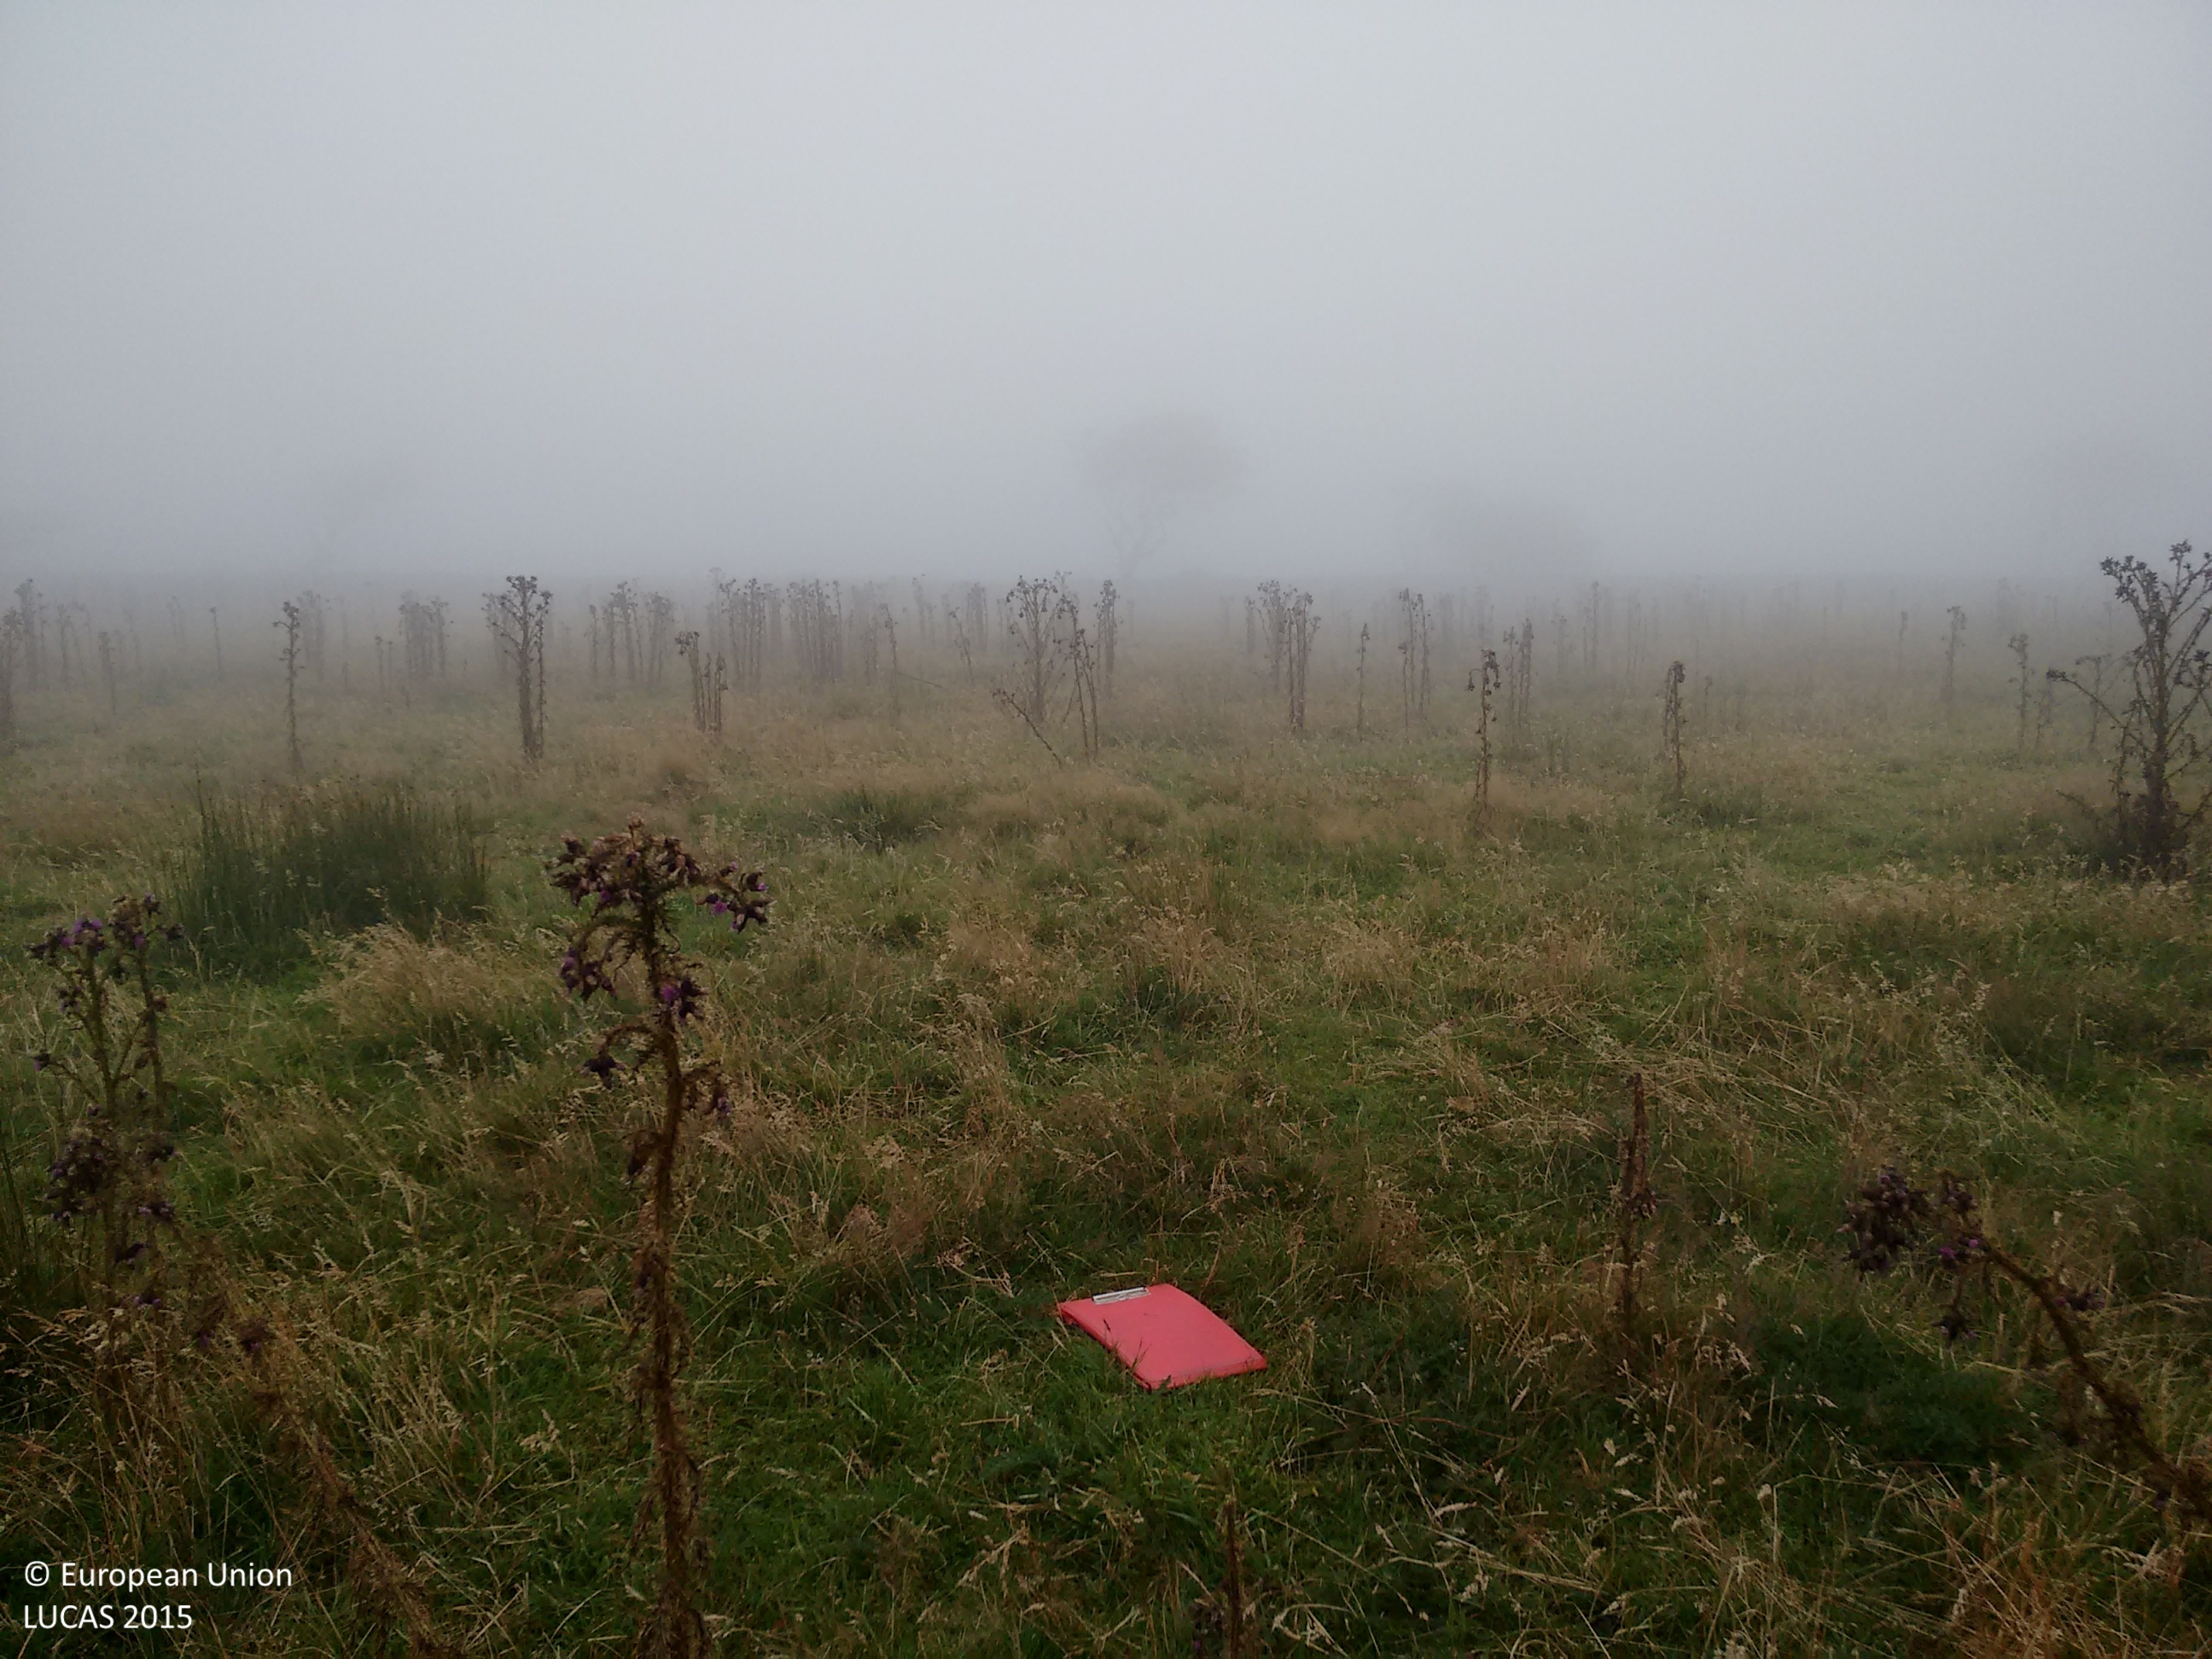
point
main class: Grassland
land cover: Grassland without tree/shrub cover
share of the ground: > 75 %
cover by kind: herbaceous plants 100 %
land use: Agriculture (excluding fallow land and kitchen gardens)
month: August
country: GB
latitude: 51.1257
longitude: -3.8219
